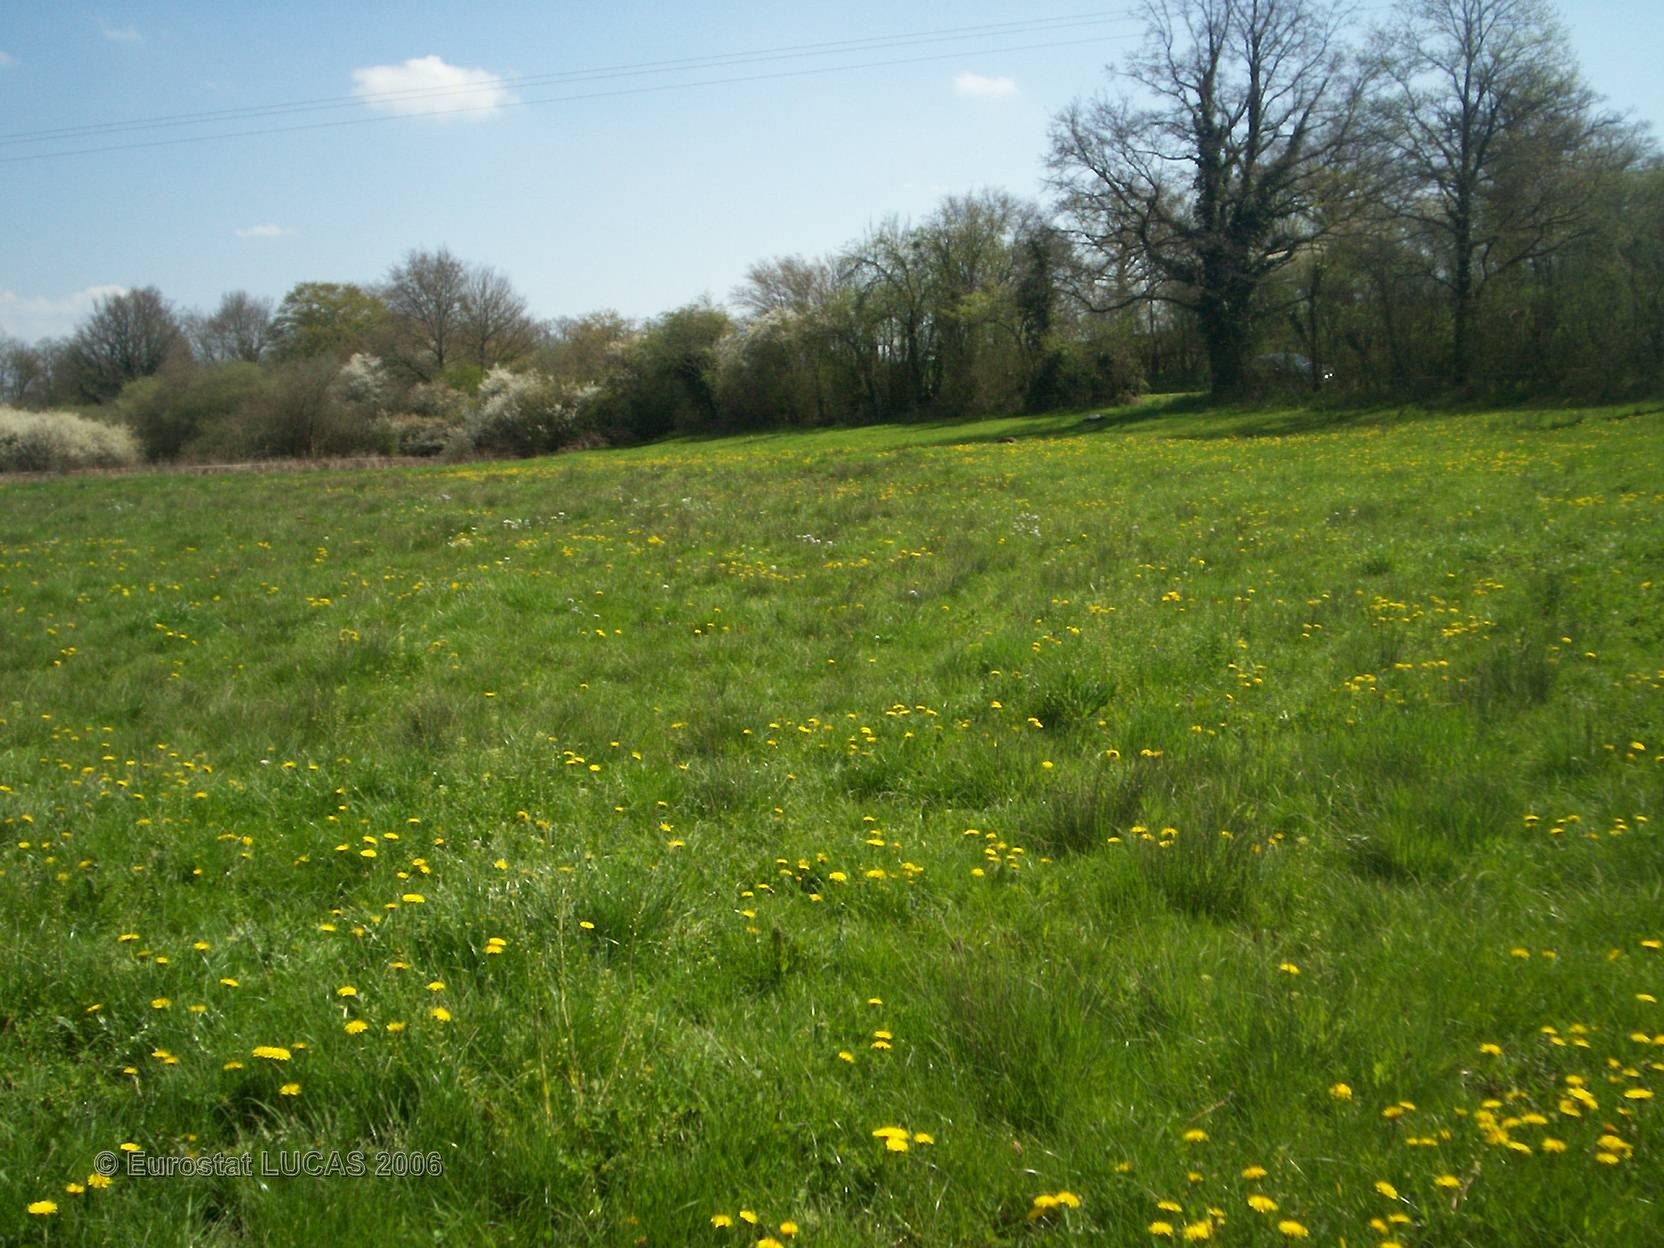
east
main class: Grassland
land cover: Grassland without tree/shrub cover
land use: Agriculture (excluding fallow land and kitchen gardens)
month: April
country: FR
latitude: 46.6335
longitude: 3.0871
